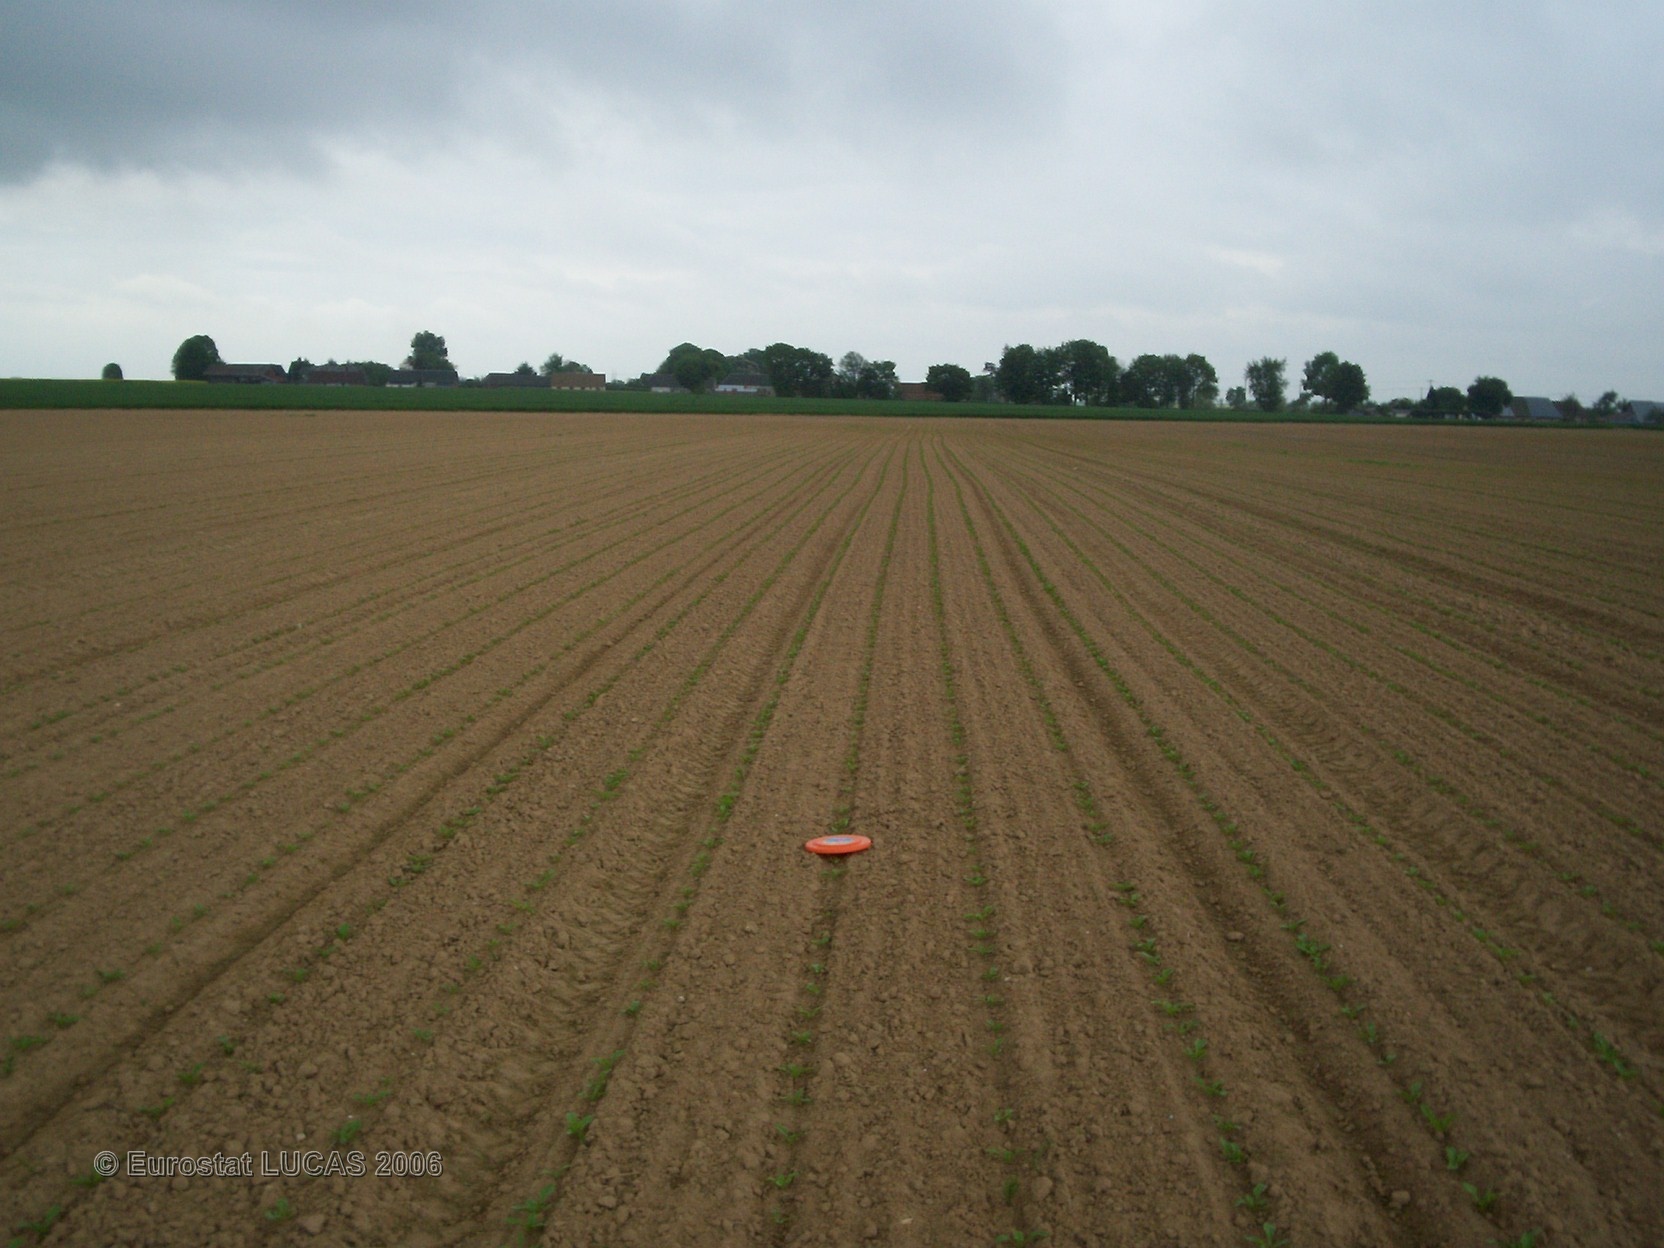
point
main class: Cropland
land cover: Sugar beet
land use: Agriculture (excluding fallow land and kitchen gardens)
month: May
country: FR
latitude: 49.1935
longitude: 0.9900
